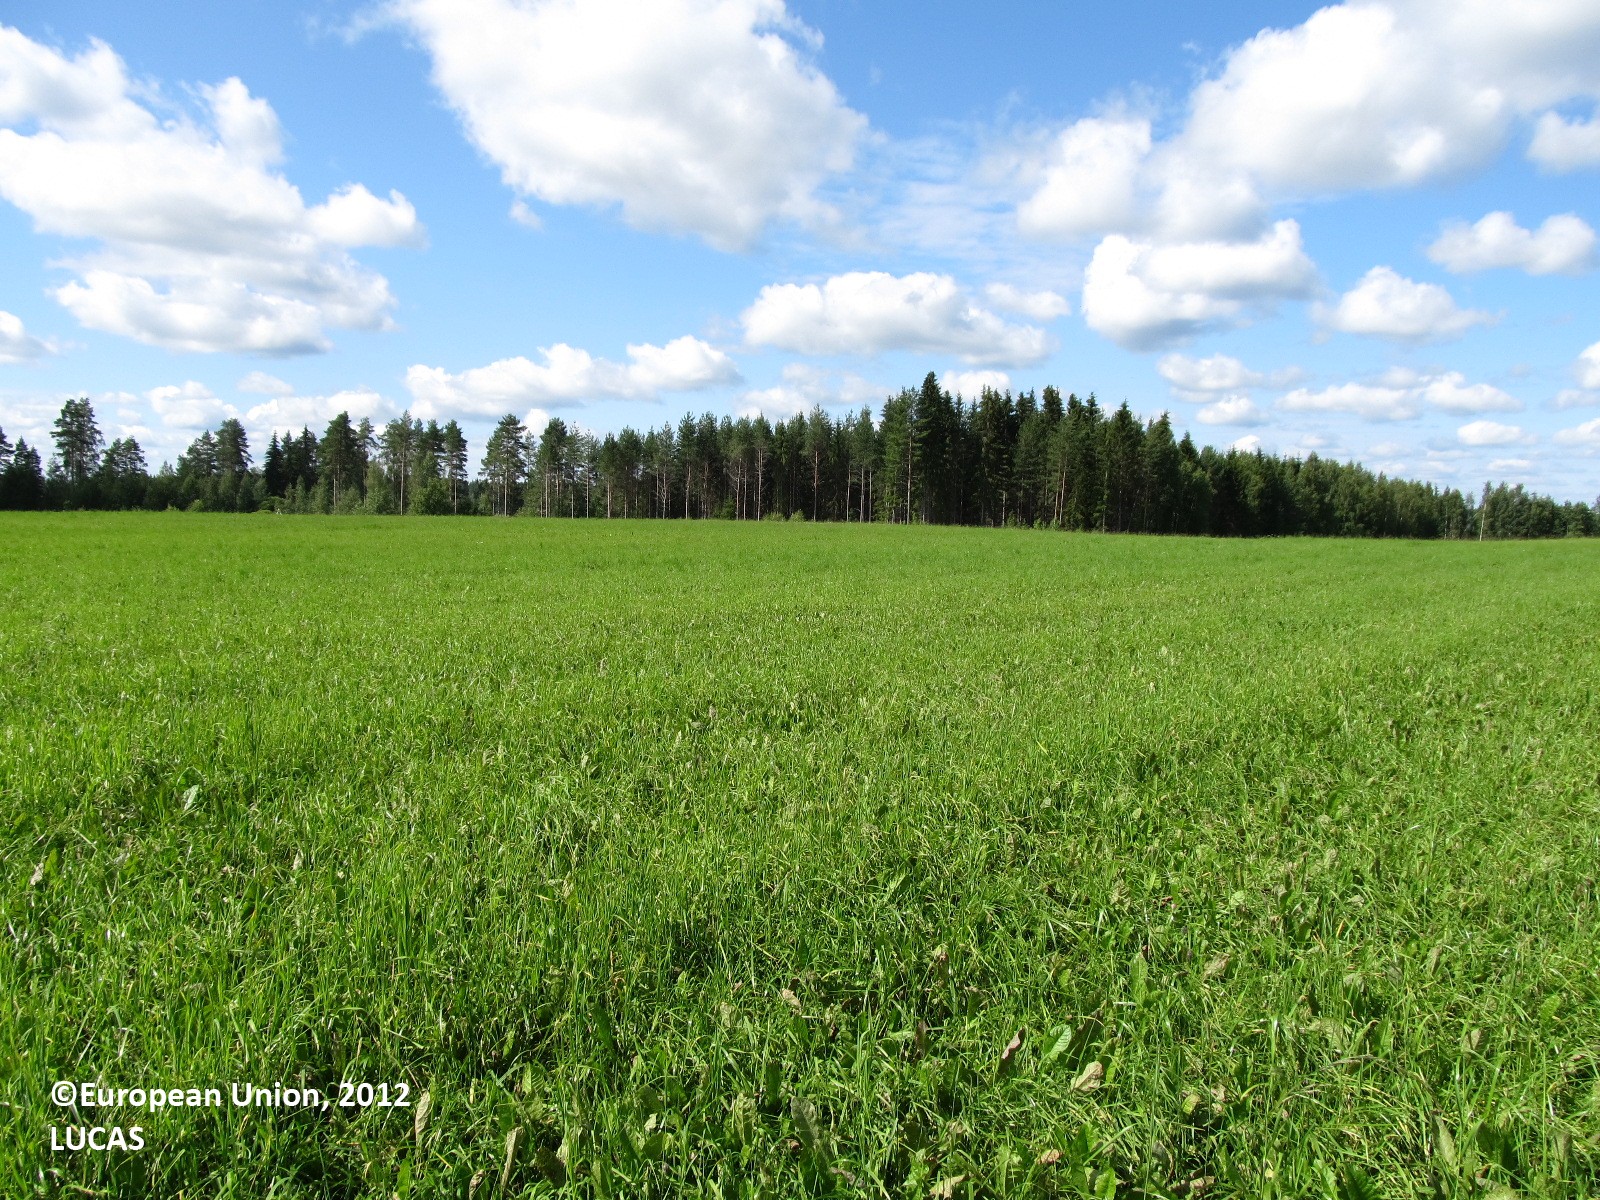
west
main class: Cropland
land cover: Temporary grasslands
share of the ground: 50 - 75 %
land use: Agriculture (excluding fallow land and kitchen gardens)
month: July
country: FI
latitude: 62.0567
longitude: 27.9583
